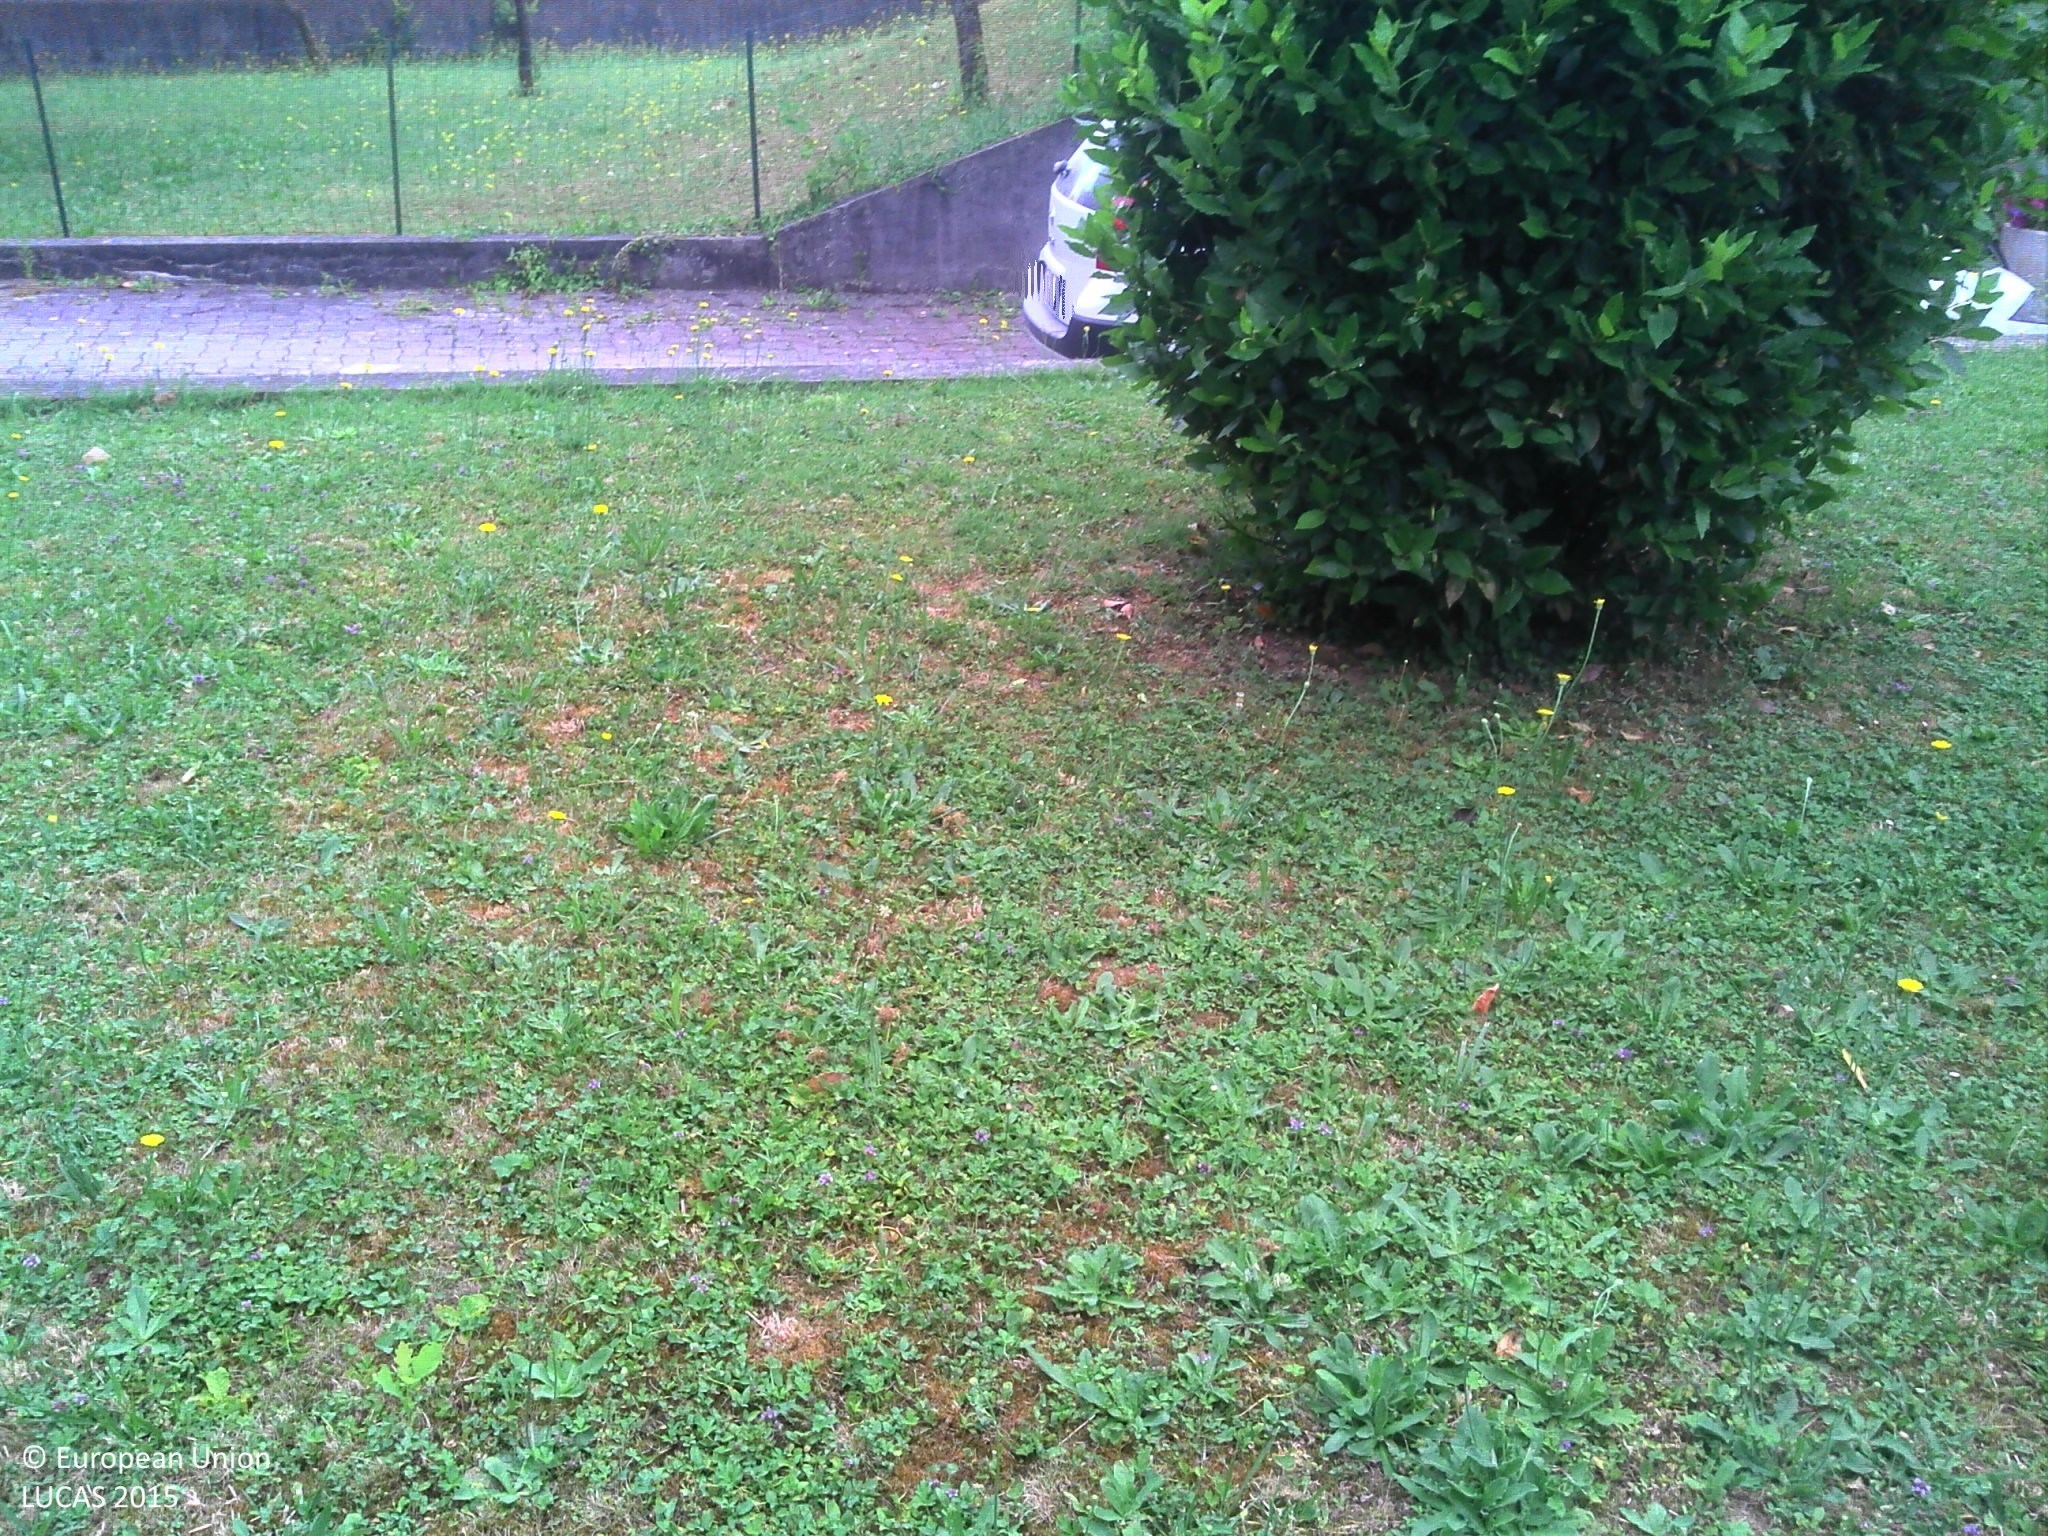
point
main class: Grassland
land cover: Grassland with sparse tree/shrub cover
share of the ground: > 75 %
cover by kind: herbaceous plants 95 %, broadleaved forest trees 5 %
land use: Residential
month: July
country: FR
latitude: 46.1606
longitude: 6.2869
